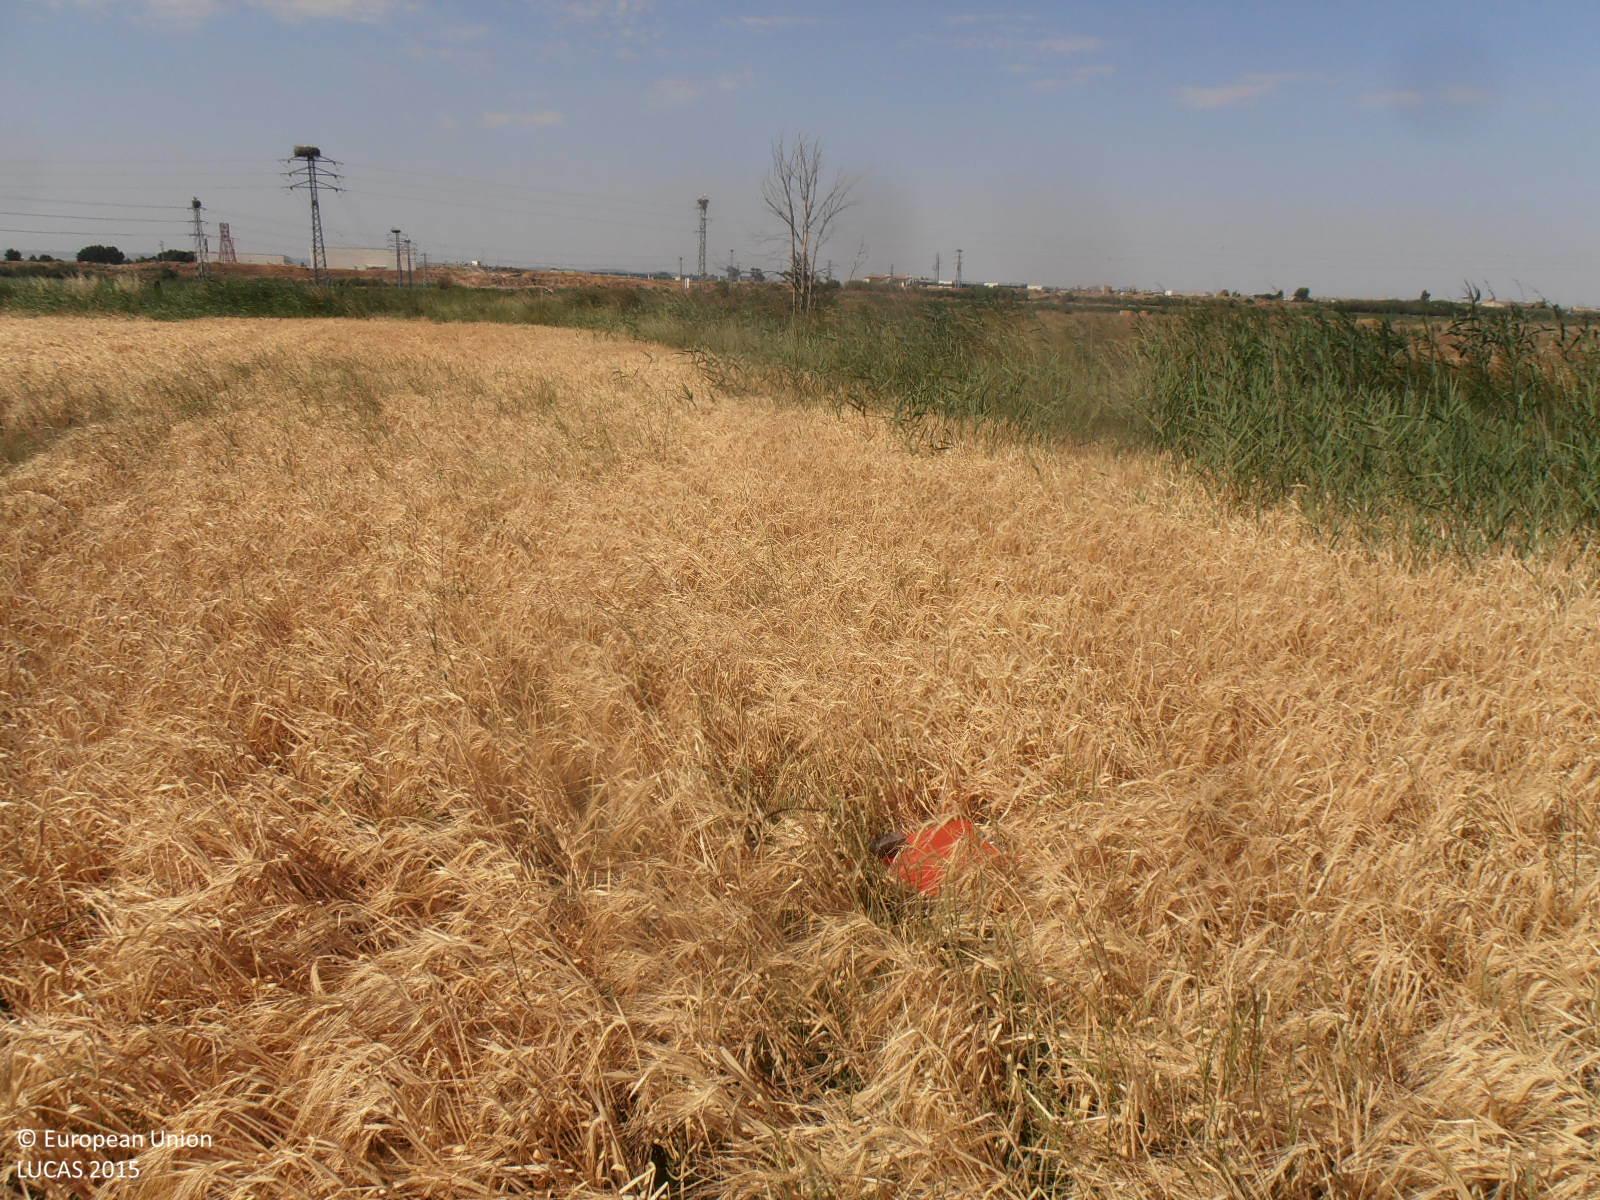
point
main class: Cropland
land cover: Barley
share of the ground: > 75 %
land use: Agriculture (excluding fallow land and kitchen gardens)
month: June
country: ES
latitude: 41.7379
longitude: -1.0495
